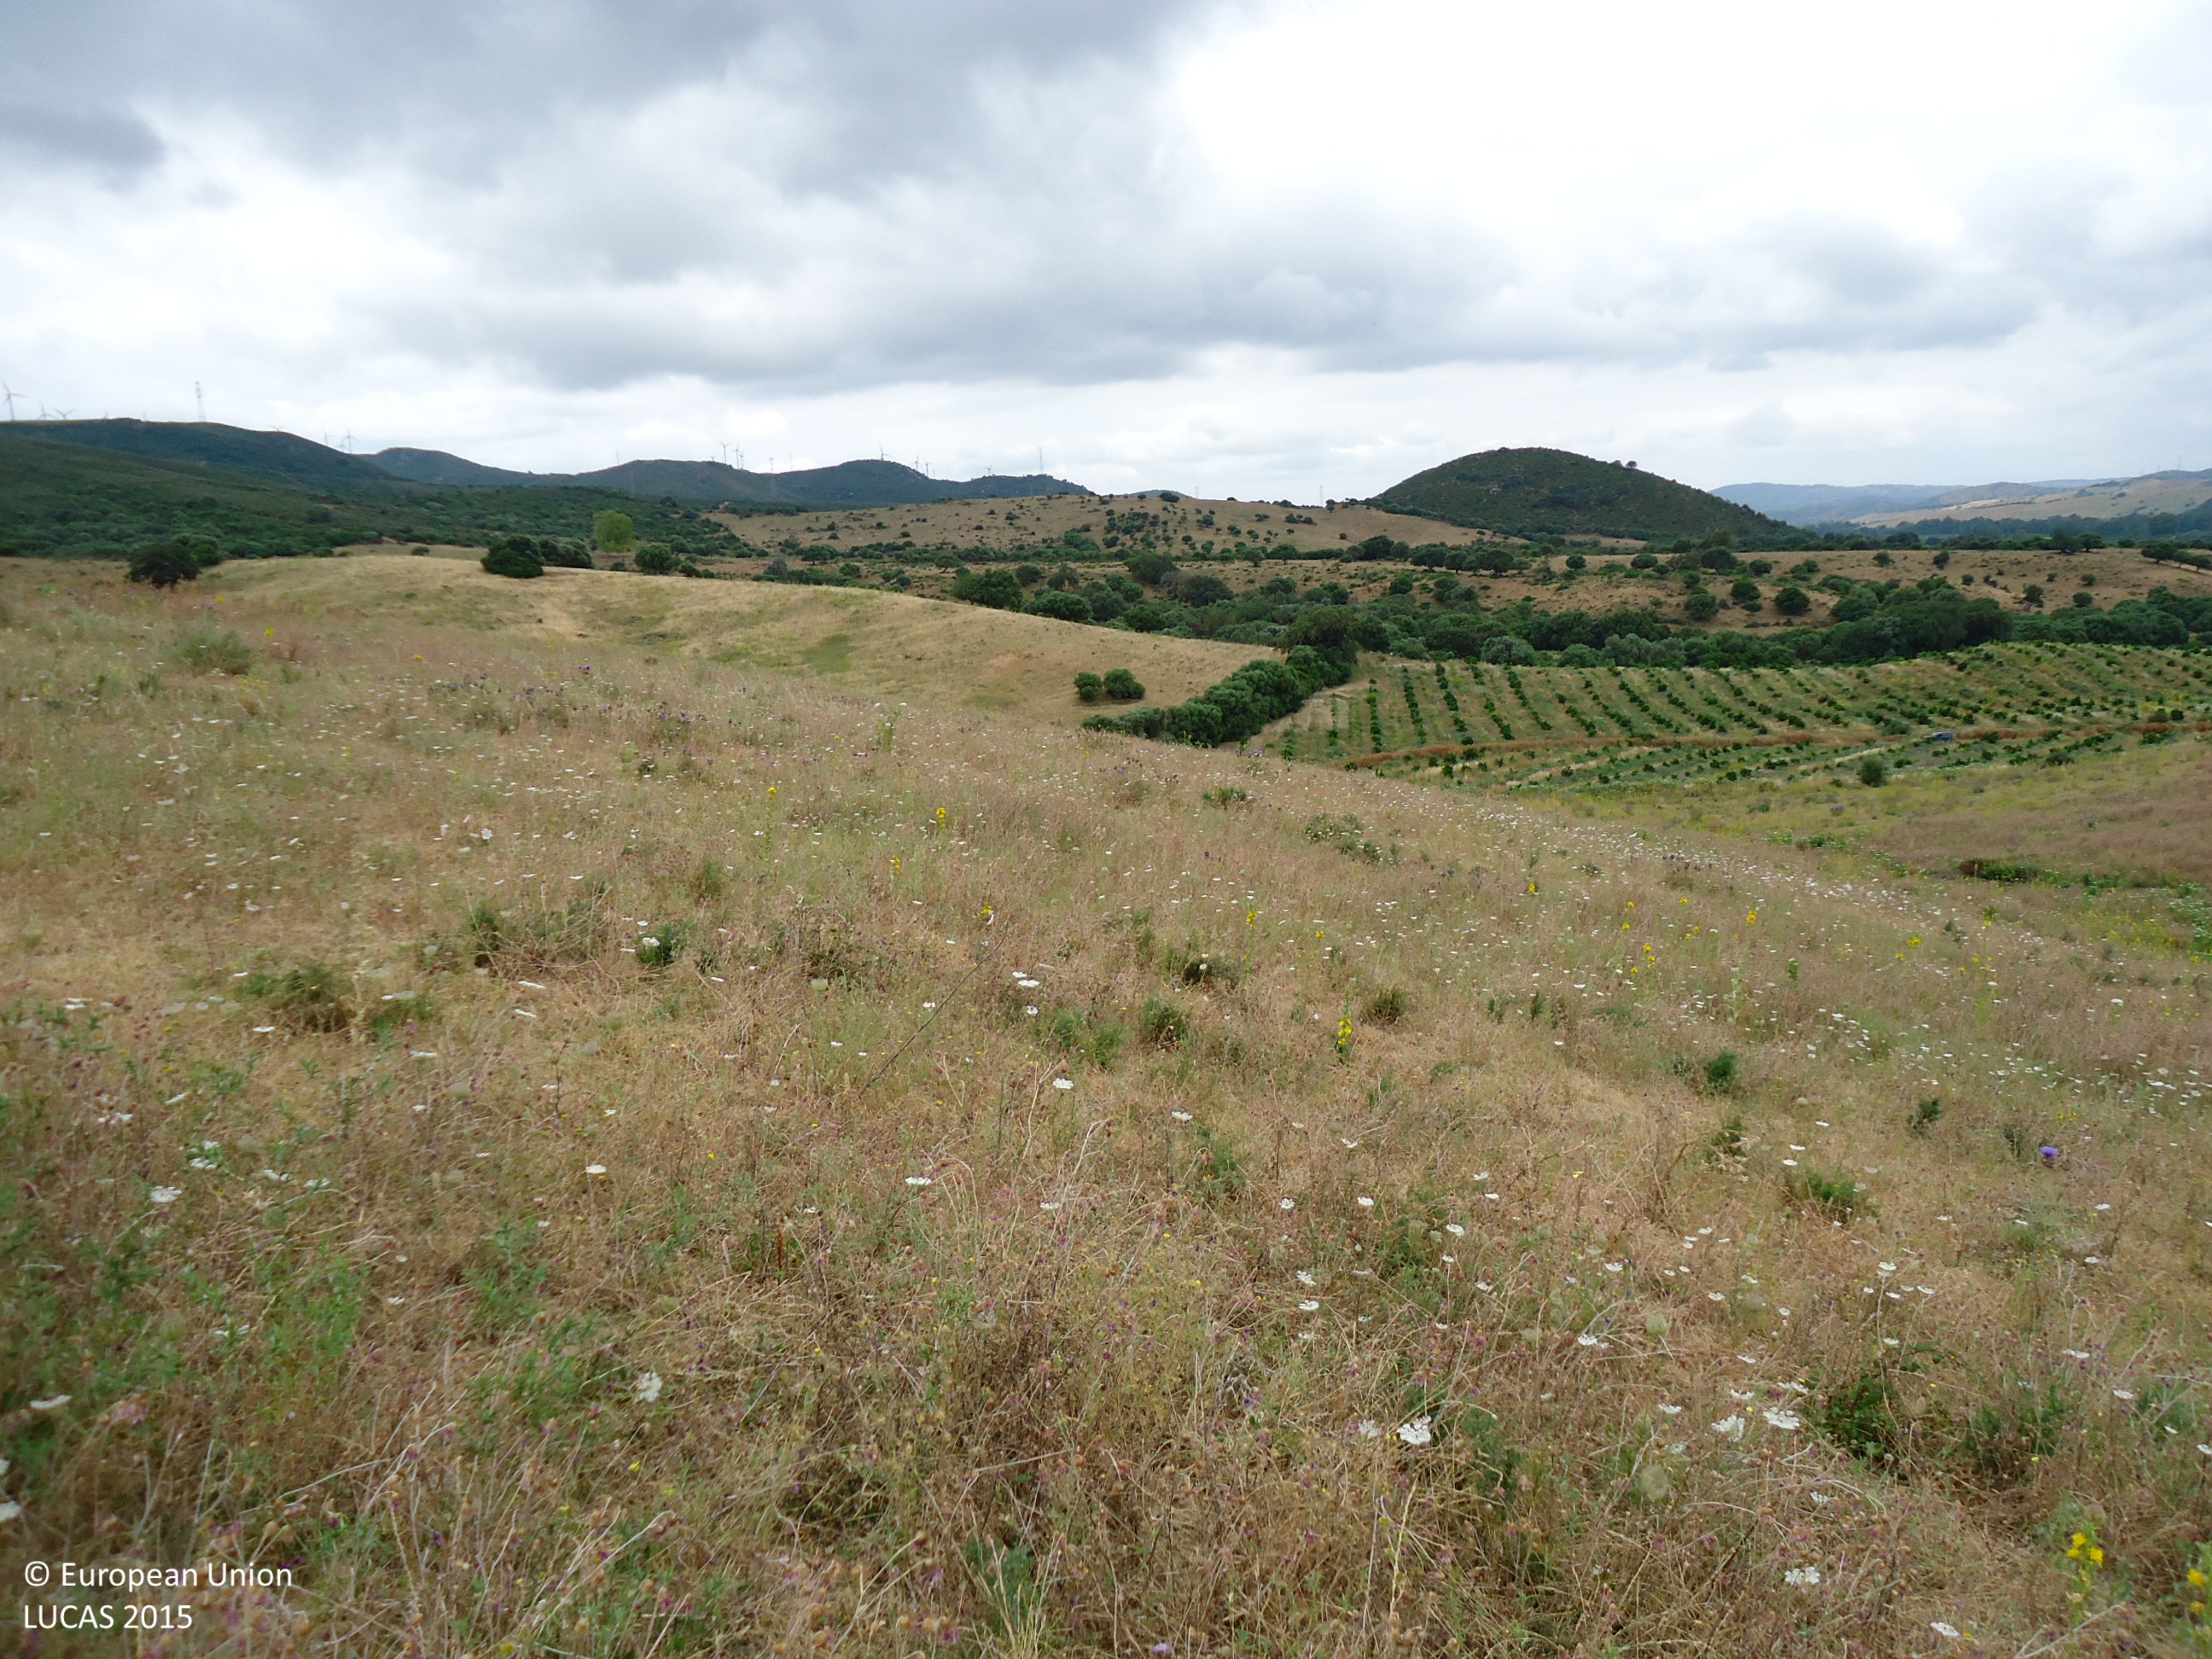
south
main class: Grassland
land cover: Spontaneously vegetated surfaces
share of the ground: > 75 %
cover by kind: herbaceous plants 100 %
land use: Agriculture (excluding fallow land and kitchen gardens)
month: June
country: ES
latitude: 36.4085
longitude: -5.3053
